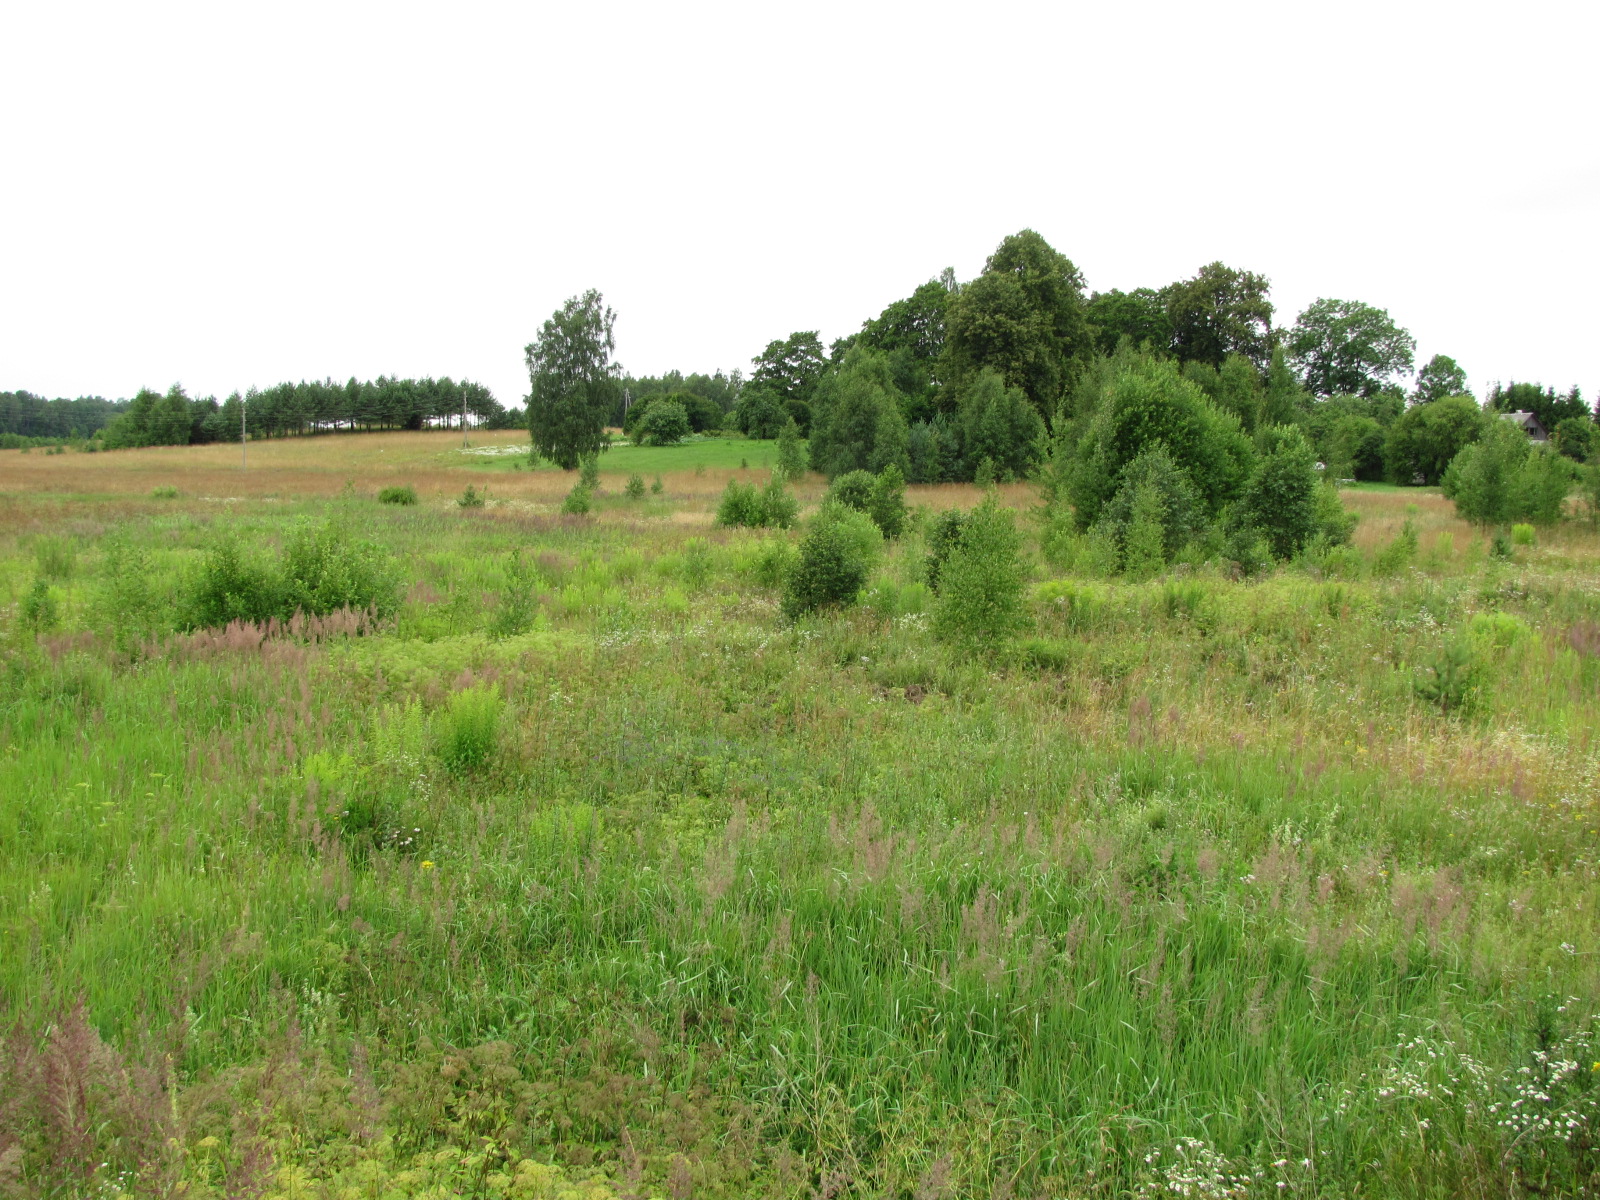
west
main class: Grassland
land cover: Grassland with sparse tree/shrub cover
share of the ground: > 75 %
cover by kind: herbaceous plants 85 %, shrubs 10 %, broadleaved forest trees 5 %
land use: Semi-natural and natural areas not in use
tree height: < 5 m
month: July
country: LV
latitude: 56.9071
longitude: 24.5631
